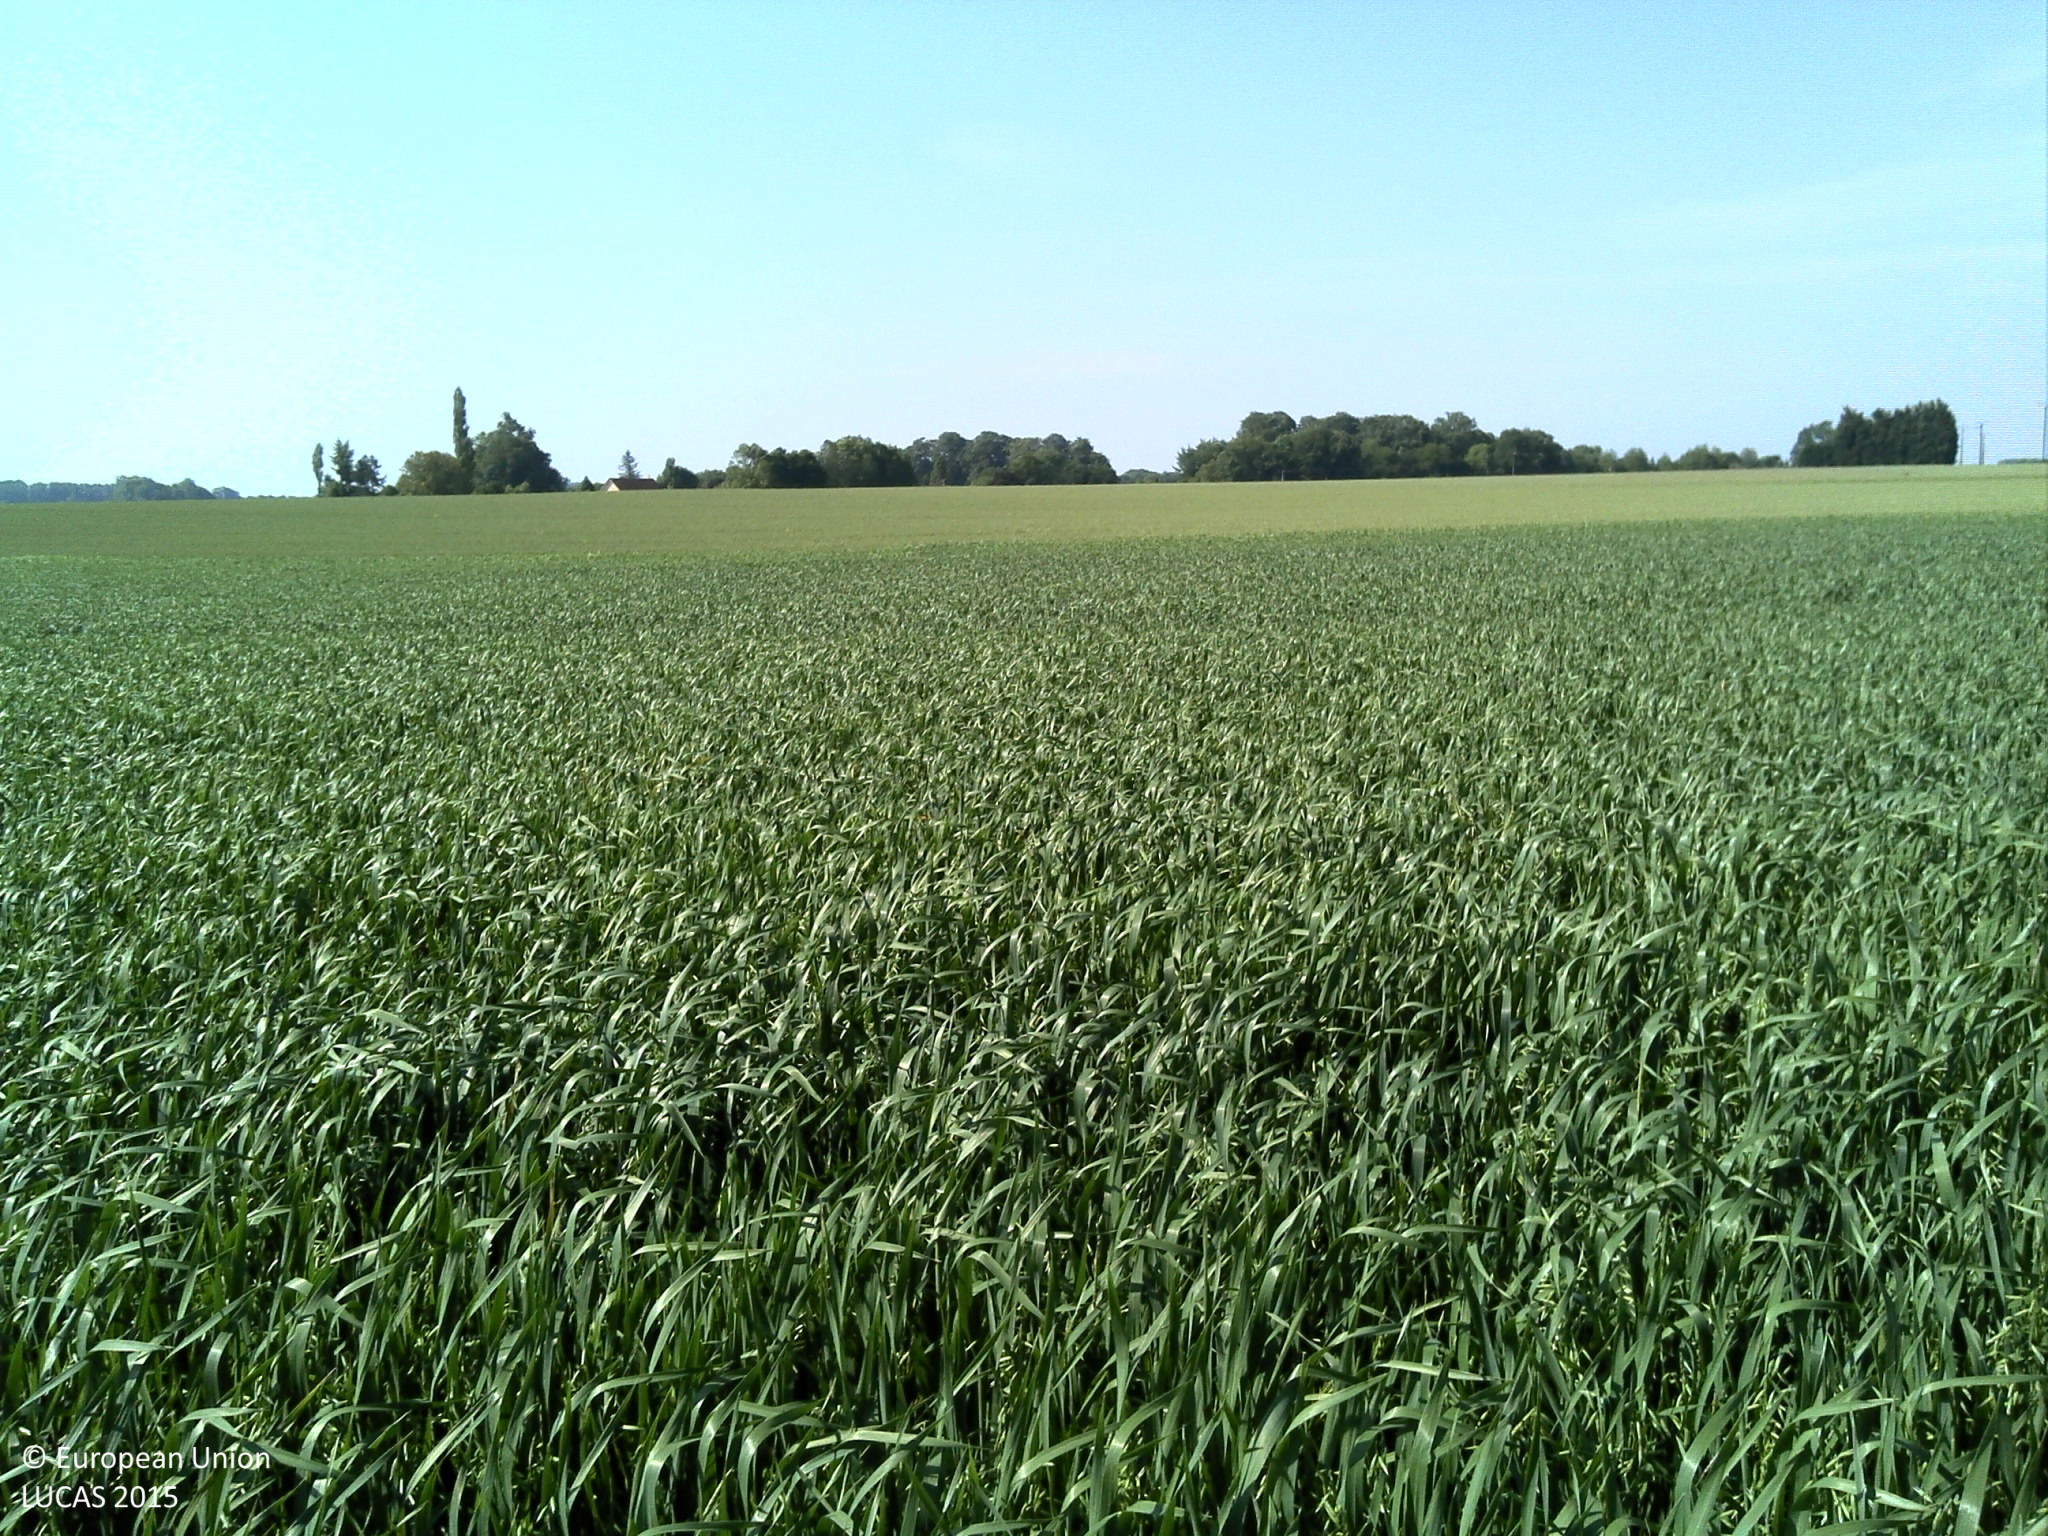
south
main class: Cropland
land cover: Oats
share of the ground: > 75 %
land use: Agriculture (excluding fallow land and kitchen gardens)
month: June
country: FR
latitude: 49.6346
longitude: 1.0751
